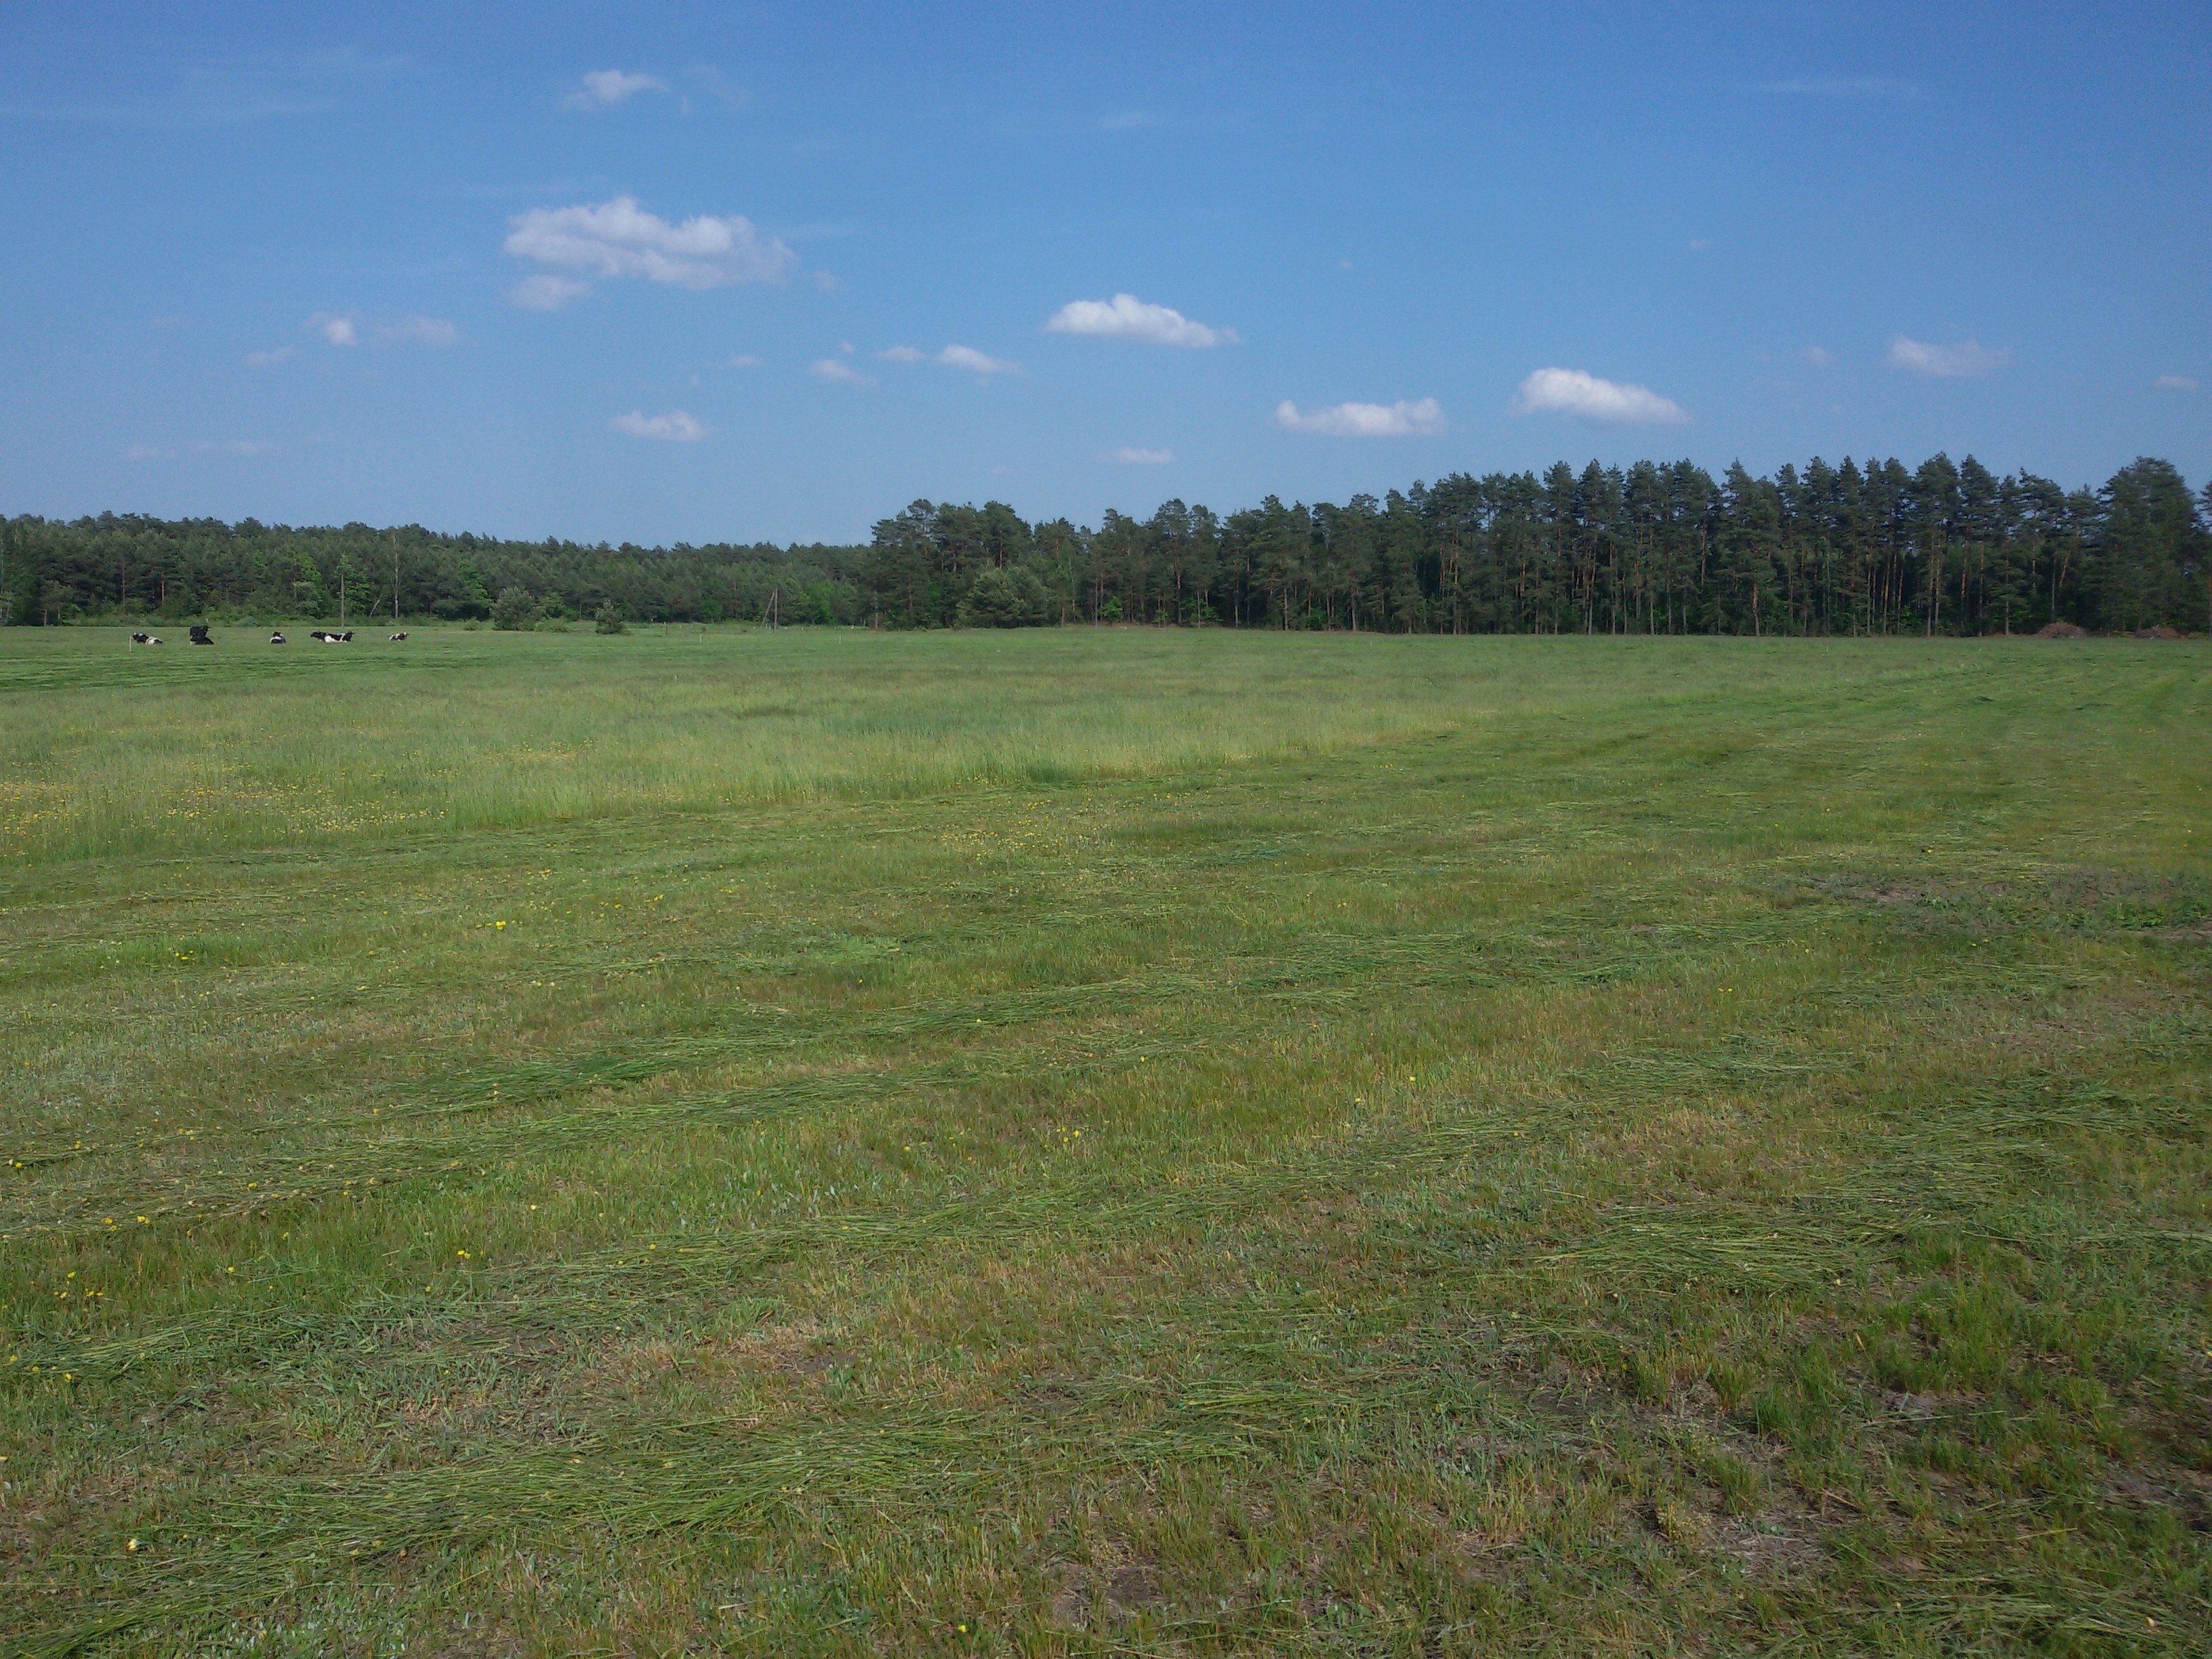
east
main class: Grassland
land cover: Grassland without tree/shrub cover
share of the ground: > 75 %
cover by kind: herbaceous plants 100 %
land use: Agriculture (excluding fallow land and kitchen gardens)
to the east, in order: Grassland without tree/shrub cover; Fences; Ditches and canals; Grassland without tree/shrub cover
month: June
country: PL
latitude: 53.4301
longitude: 21.5343
